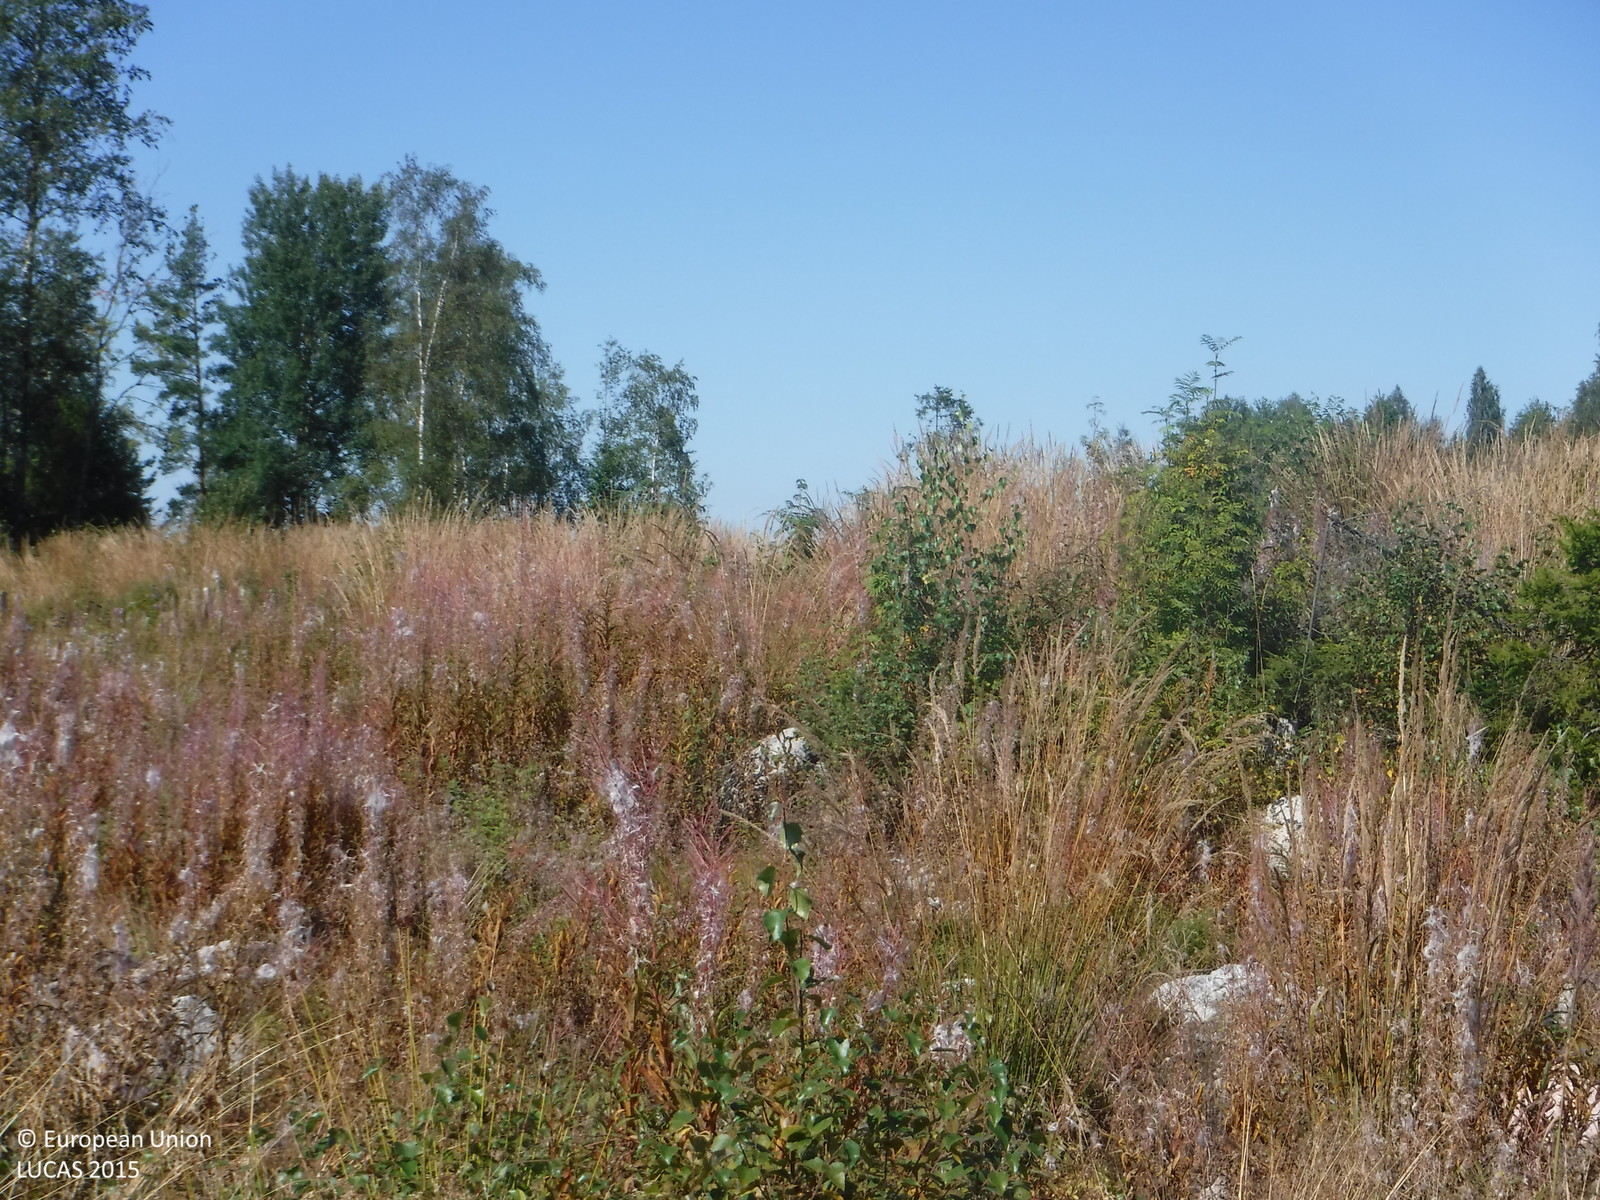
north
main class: Grassland
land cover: Spontaneously vegetated surfaces
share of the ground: > 75 %
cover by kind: herbaceous plants 75 %, consolidated bare surface 10 %, shrubs 5 %, unconsolidated bare surface 5 %
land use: Forestry
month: August
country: FI
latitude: 61.2192
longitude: 22.4086
